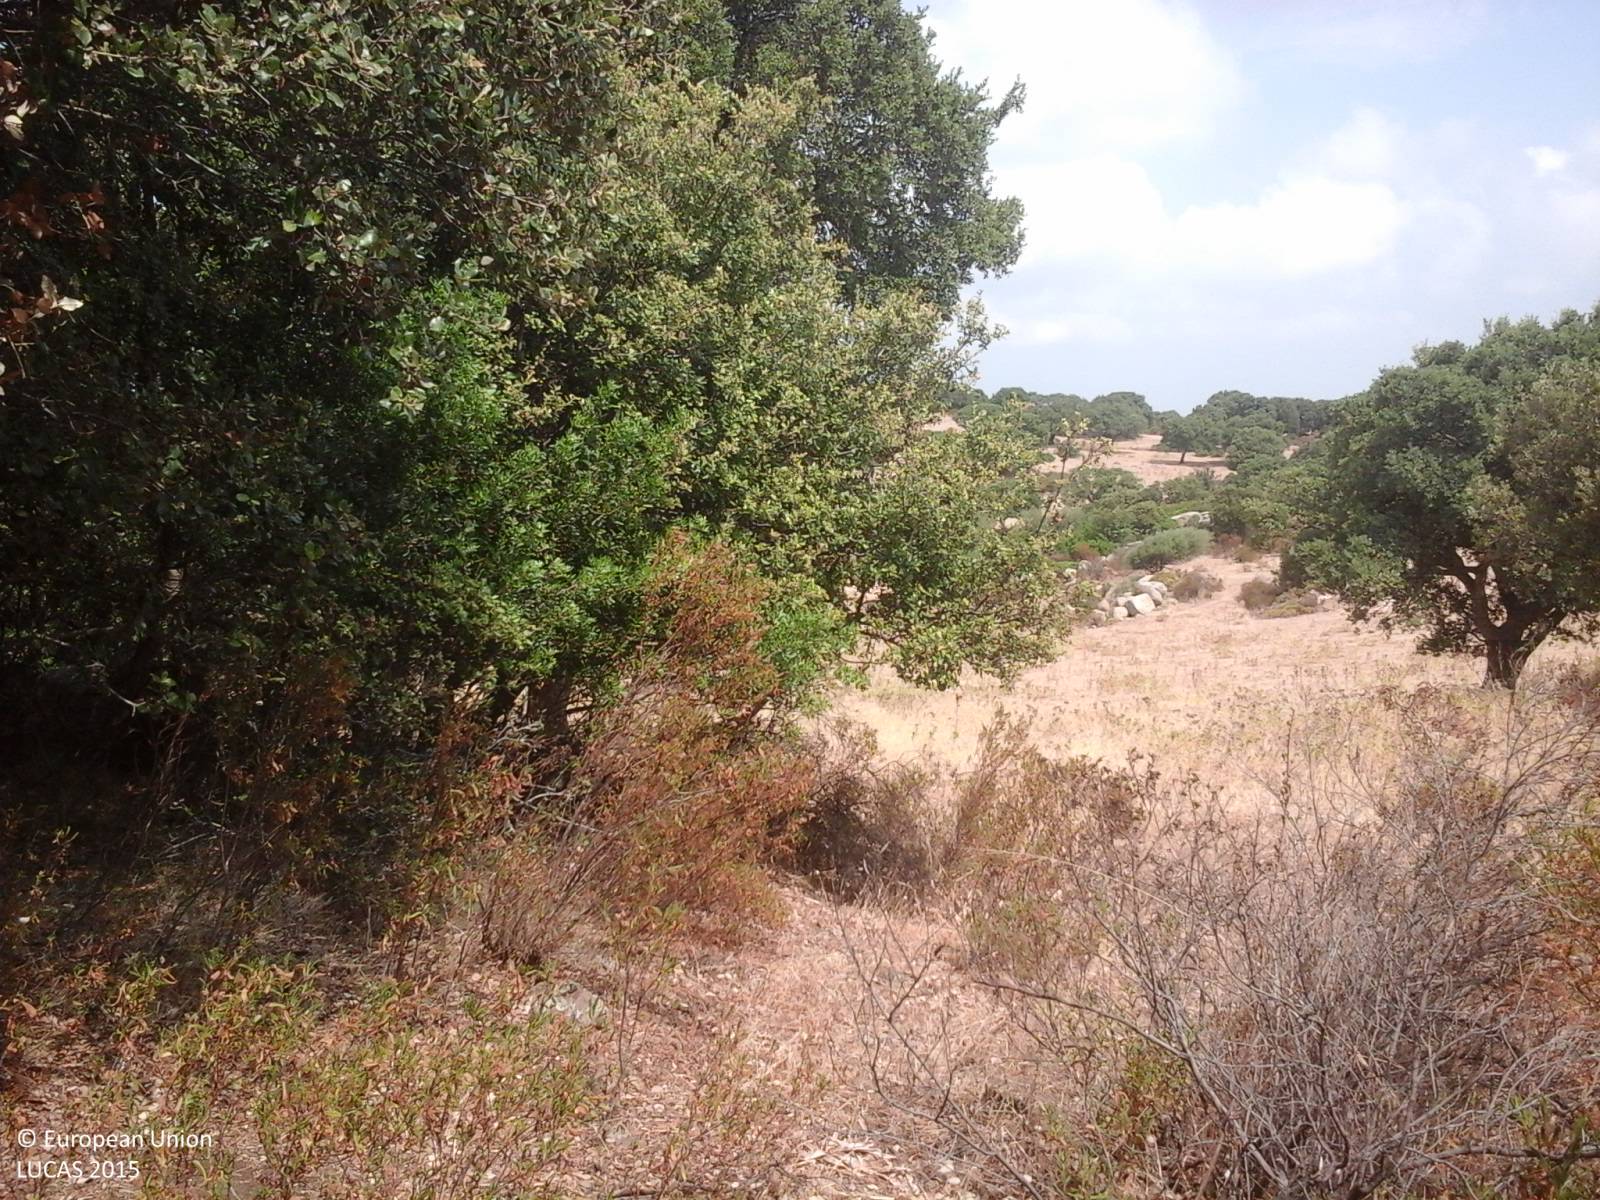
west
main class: Shrubland
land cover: Shrubland with sparse tree cover
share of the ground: > 75 %
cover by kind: shrubs 90 %, broadleaved forest trees 5 %, unconsolidated bare surface 5 %
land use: Agriculture (excluding fallow land and kitchen gardens)
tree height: > 5 m
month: July
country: IT
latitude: 40.8088
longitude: 9.4691
